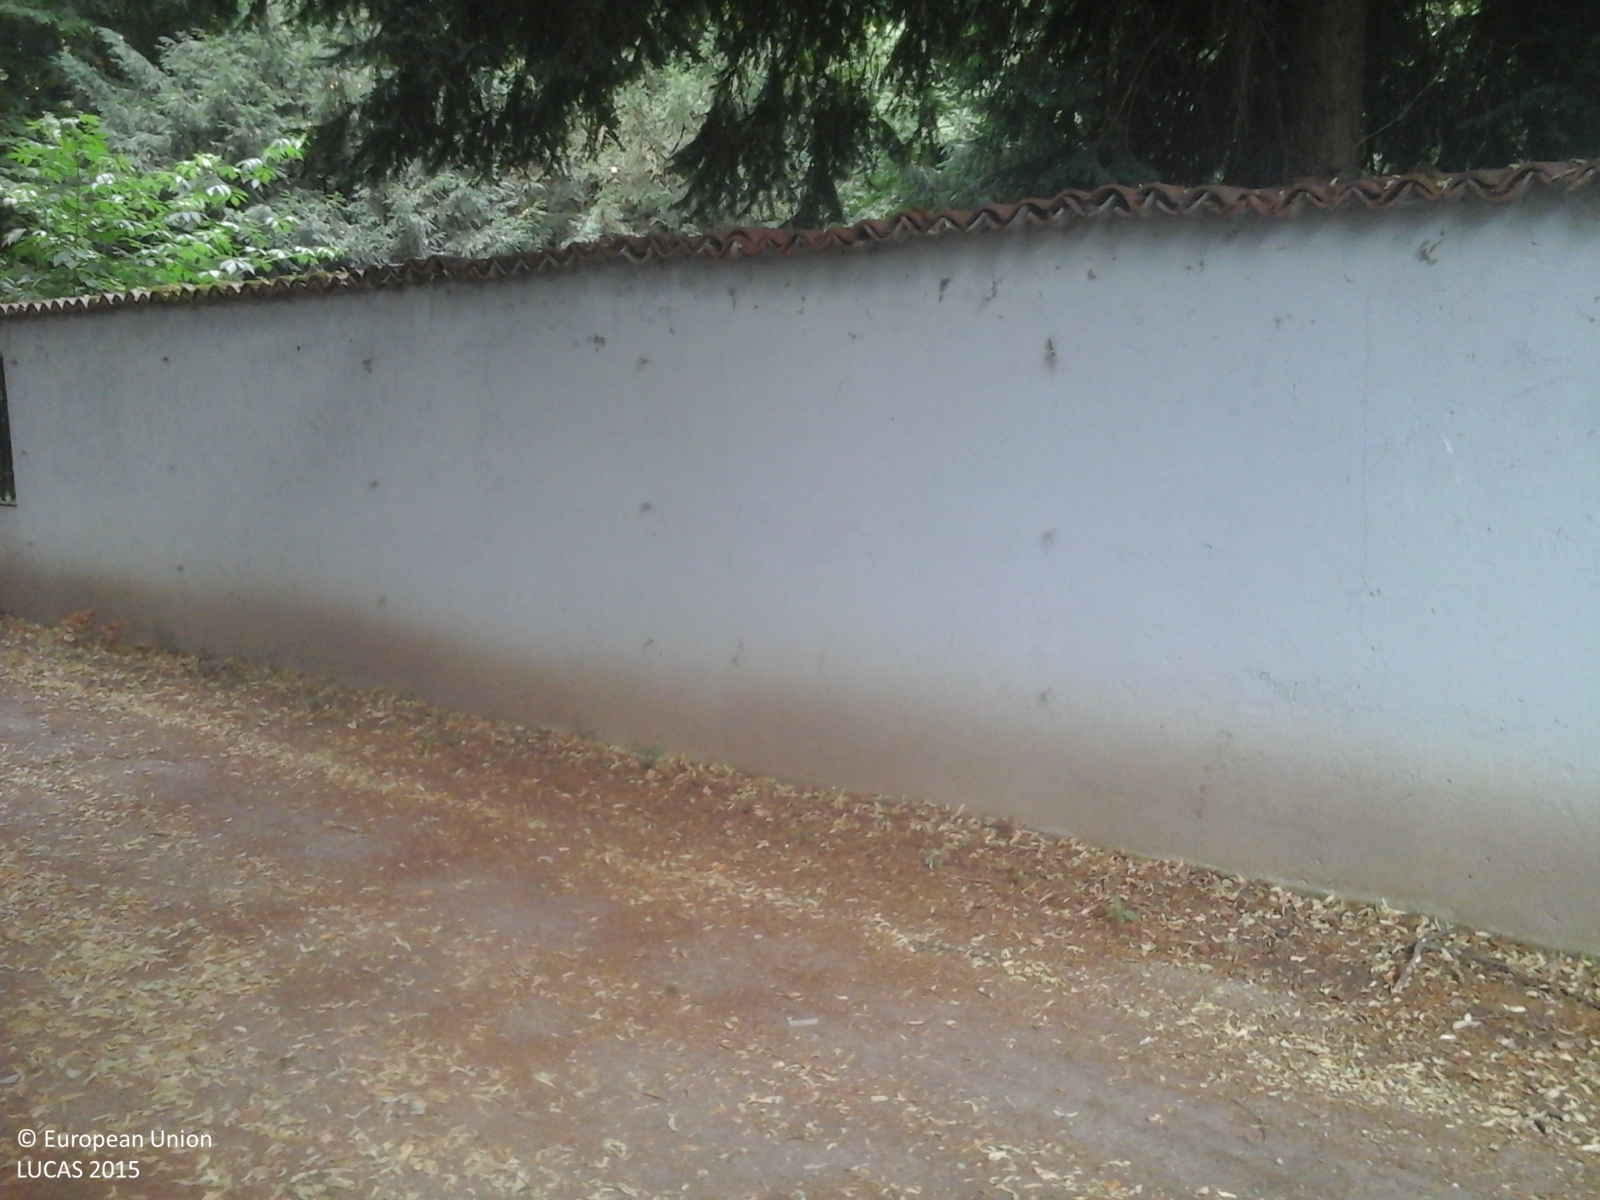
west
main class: Woodland
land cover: Other mixed woodland
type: coniferous forest of the mediterranean region
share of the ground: > 75 %
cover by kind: coniferous forest trees 55 %, broadleaved forest trees 45 %
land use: Amenities, museums, leisure
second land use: Sport
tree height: > 5 m
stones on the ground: 25 - 50 %
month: June
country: IT
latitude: 45.6107
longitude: 9.3727
